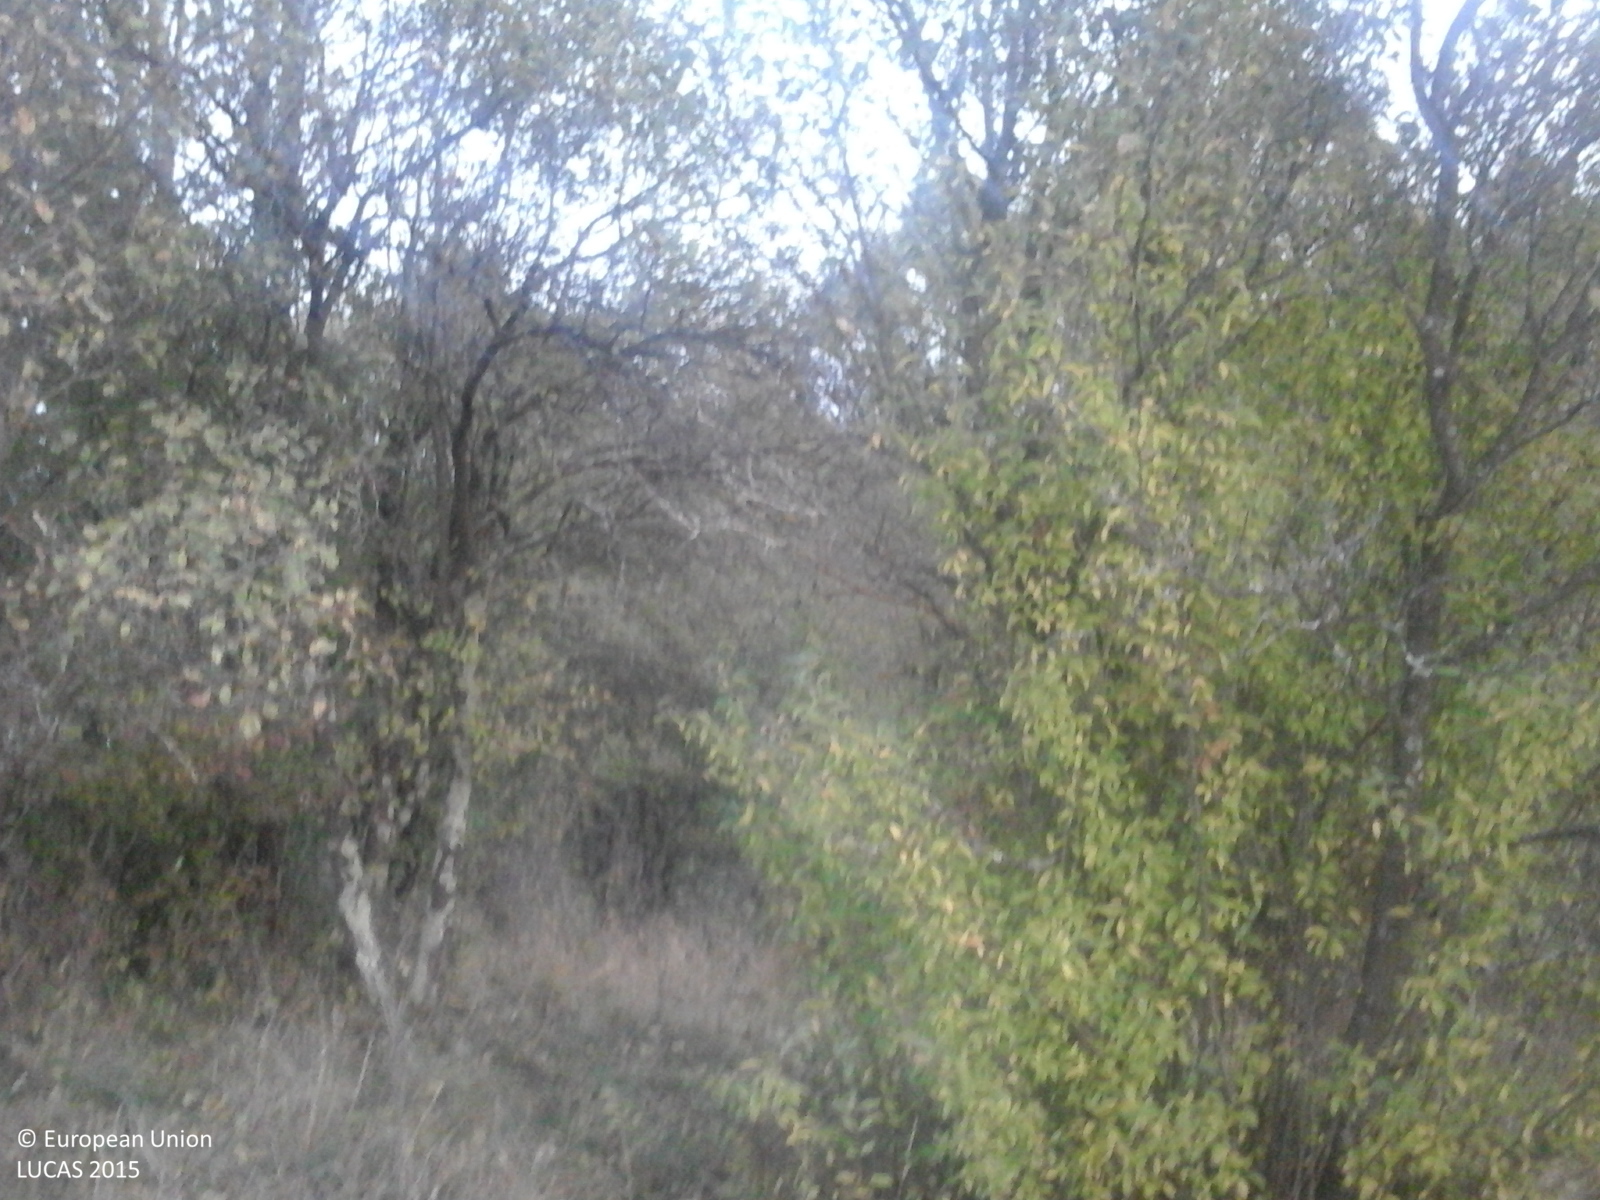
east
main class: Grassland
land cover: Grassland with sparse tree/shrub cover
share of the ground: > 75 %
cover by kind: herbaceous plants 95 %, broadleaved forest trees 5 %
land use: Fallow land
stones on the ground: < 10 %
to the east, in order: Grassland with sparse tree/shrub cover; Broadleaved woodland; Rivers and streams; Broadleaved woodland; Grassland with sparse tree/shrub cover; Lines of trees; Tracks; Lines of trees; Grassland without tree/shrub cover; Broadleaved woodland; Rivers and streams; Broadleaved woodland; Grassland without tree/shrub cover; Grassland with sparse tree/shrub cover
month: October
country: RO
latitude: 46.1947
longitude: 25.3016
